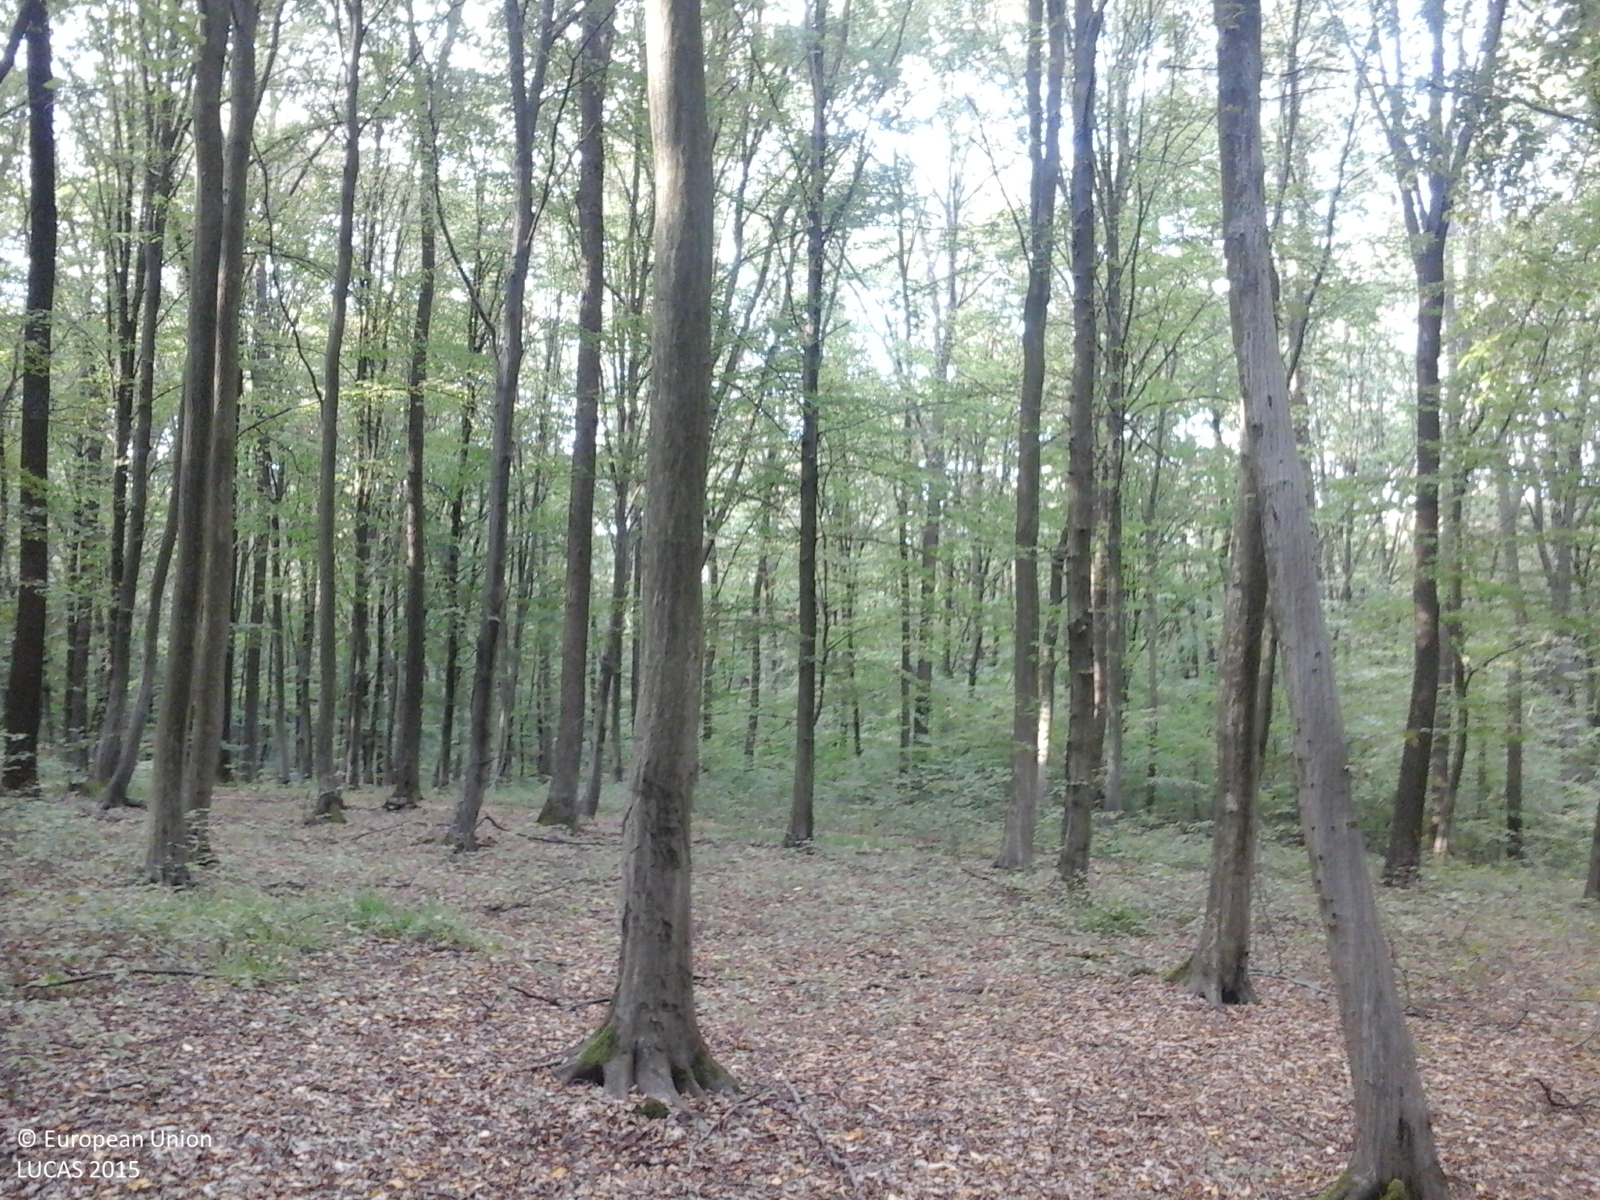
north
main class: Woodland
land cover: Broadleaved woodland
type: beech forest
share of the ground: > 75 %
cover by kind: broadleaved forest trees 100 %
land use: Forestry
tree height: > 5 m
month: September
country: RO
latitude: 47.6240
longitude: 23.3653
